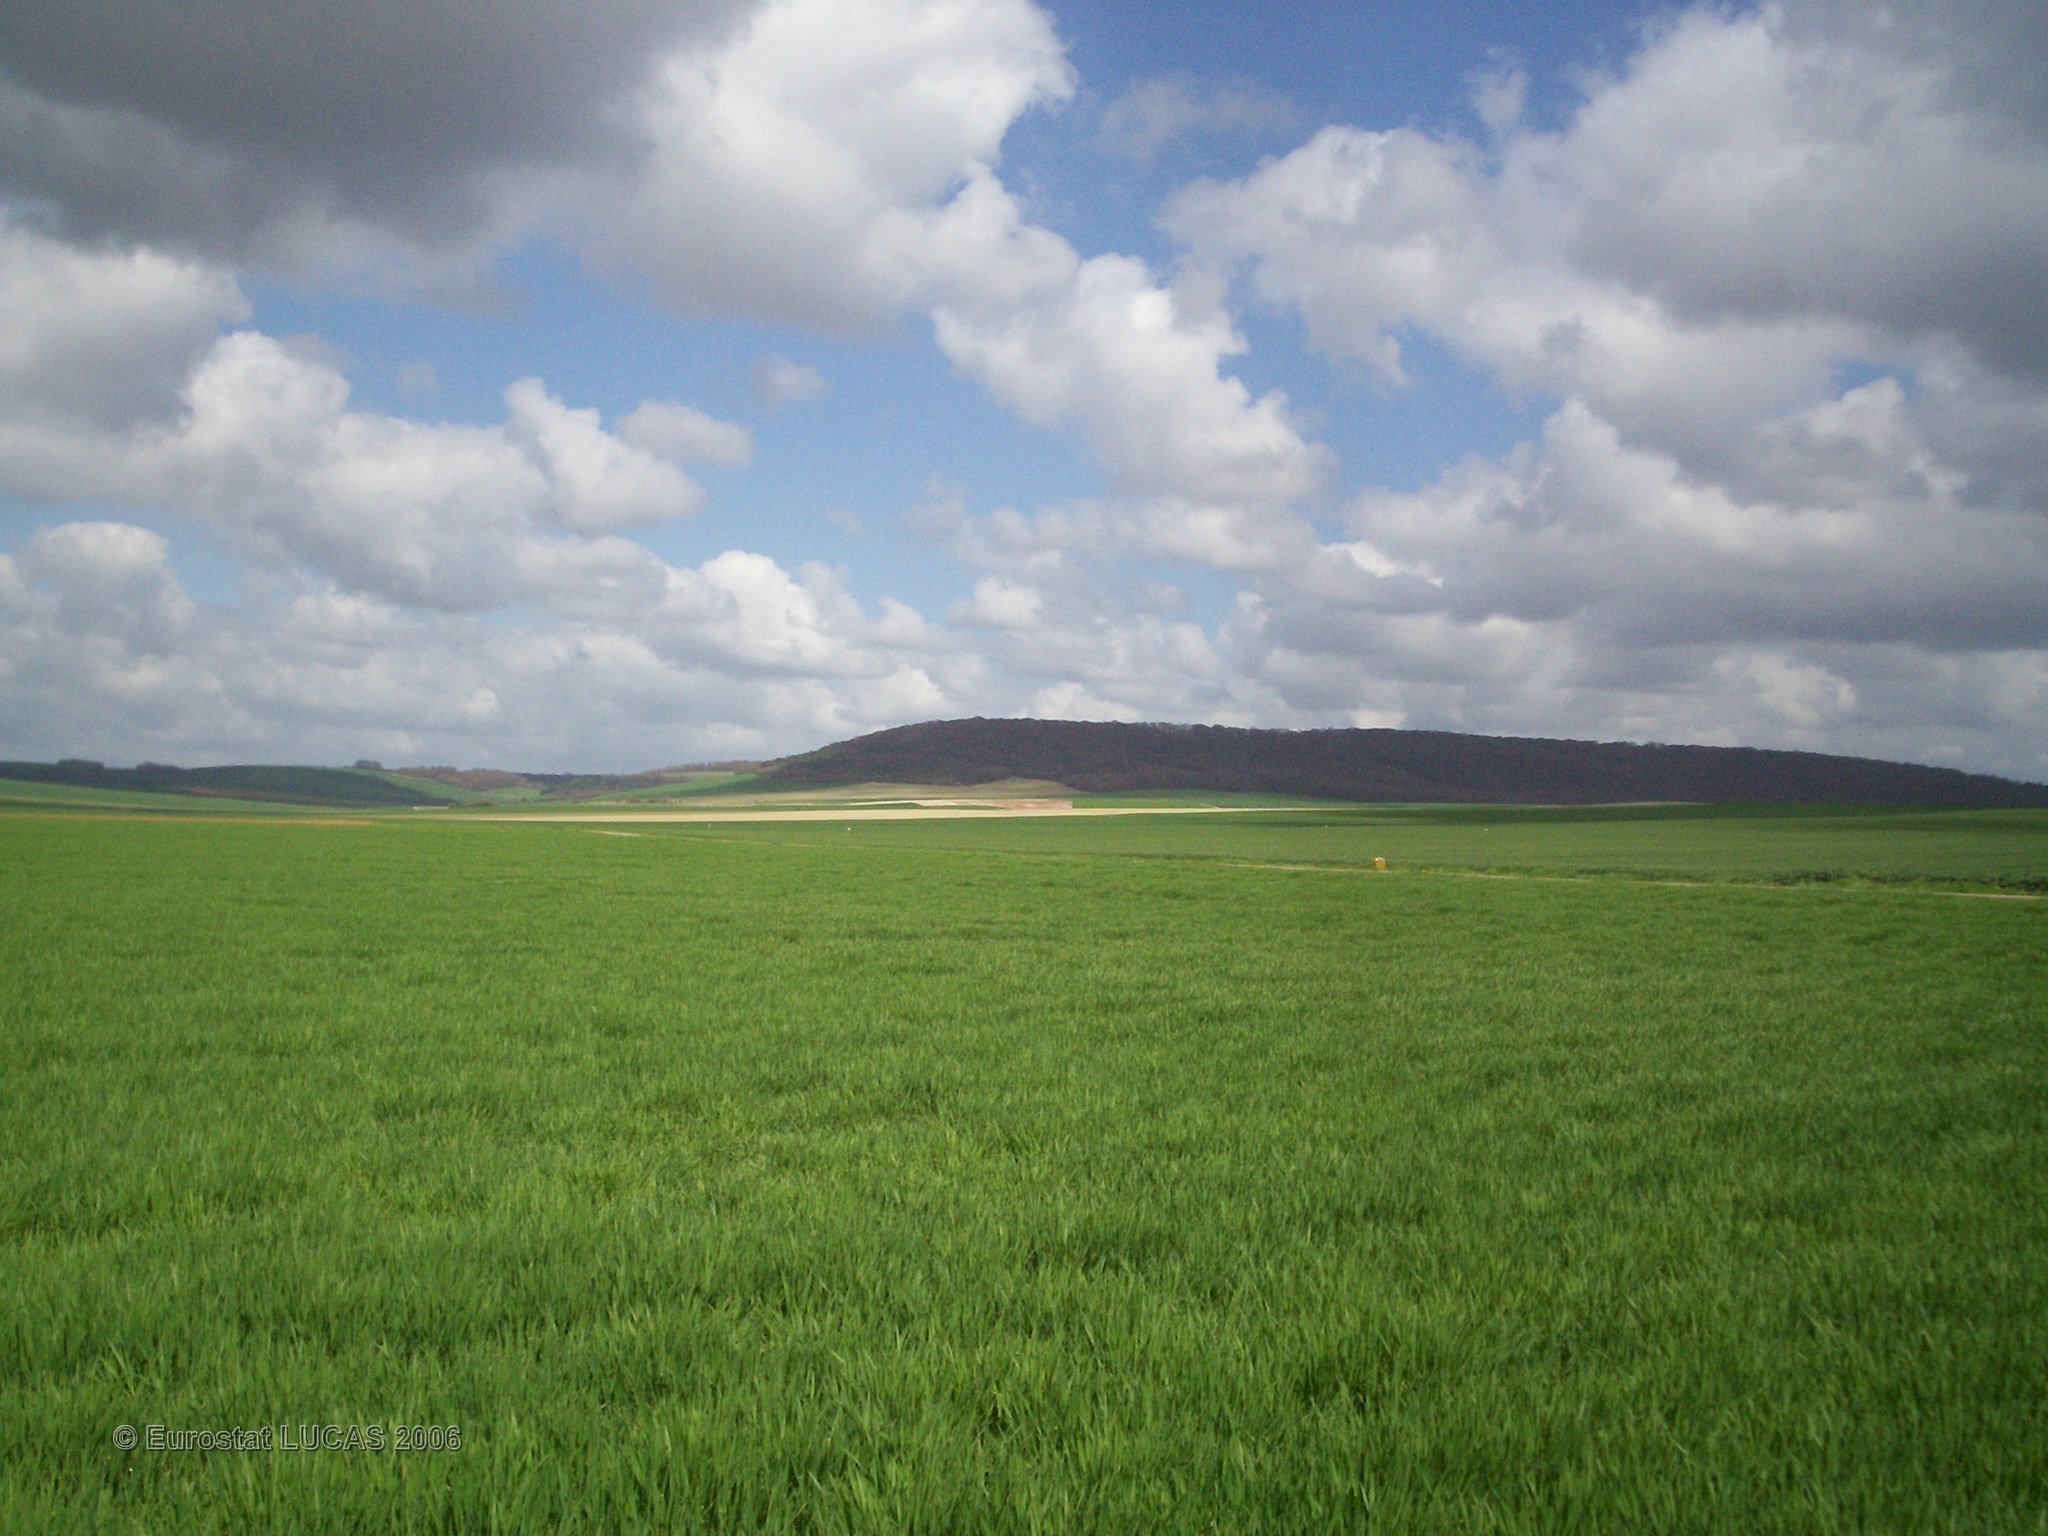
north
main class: Cropland
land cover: Barley
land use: Agriculture (excluding fallow land and kitchen gardens)
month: April
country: FR
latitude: 48.0676
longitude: 3.8093
